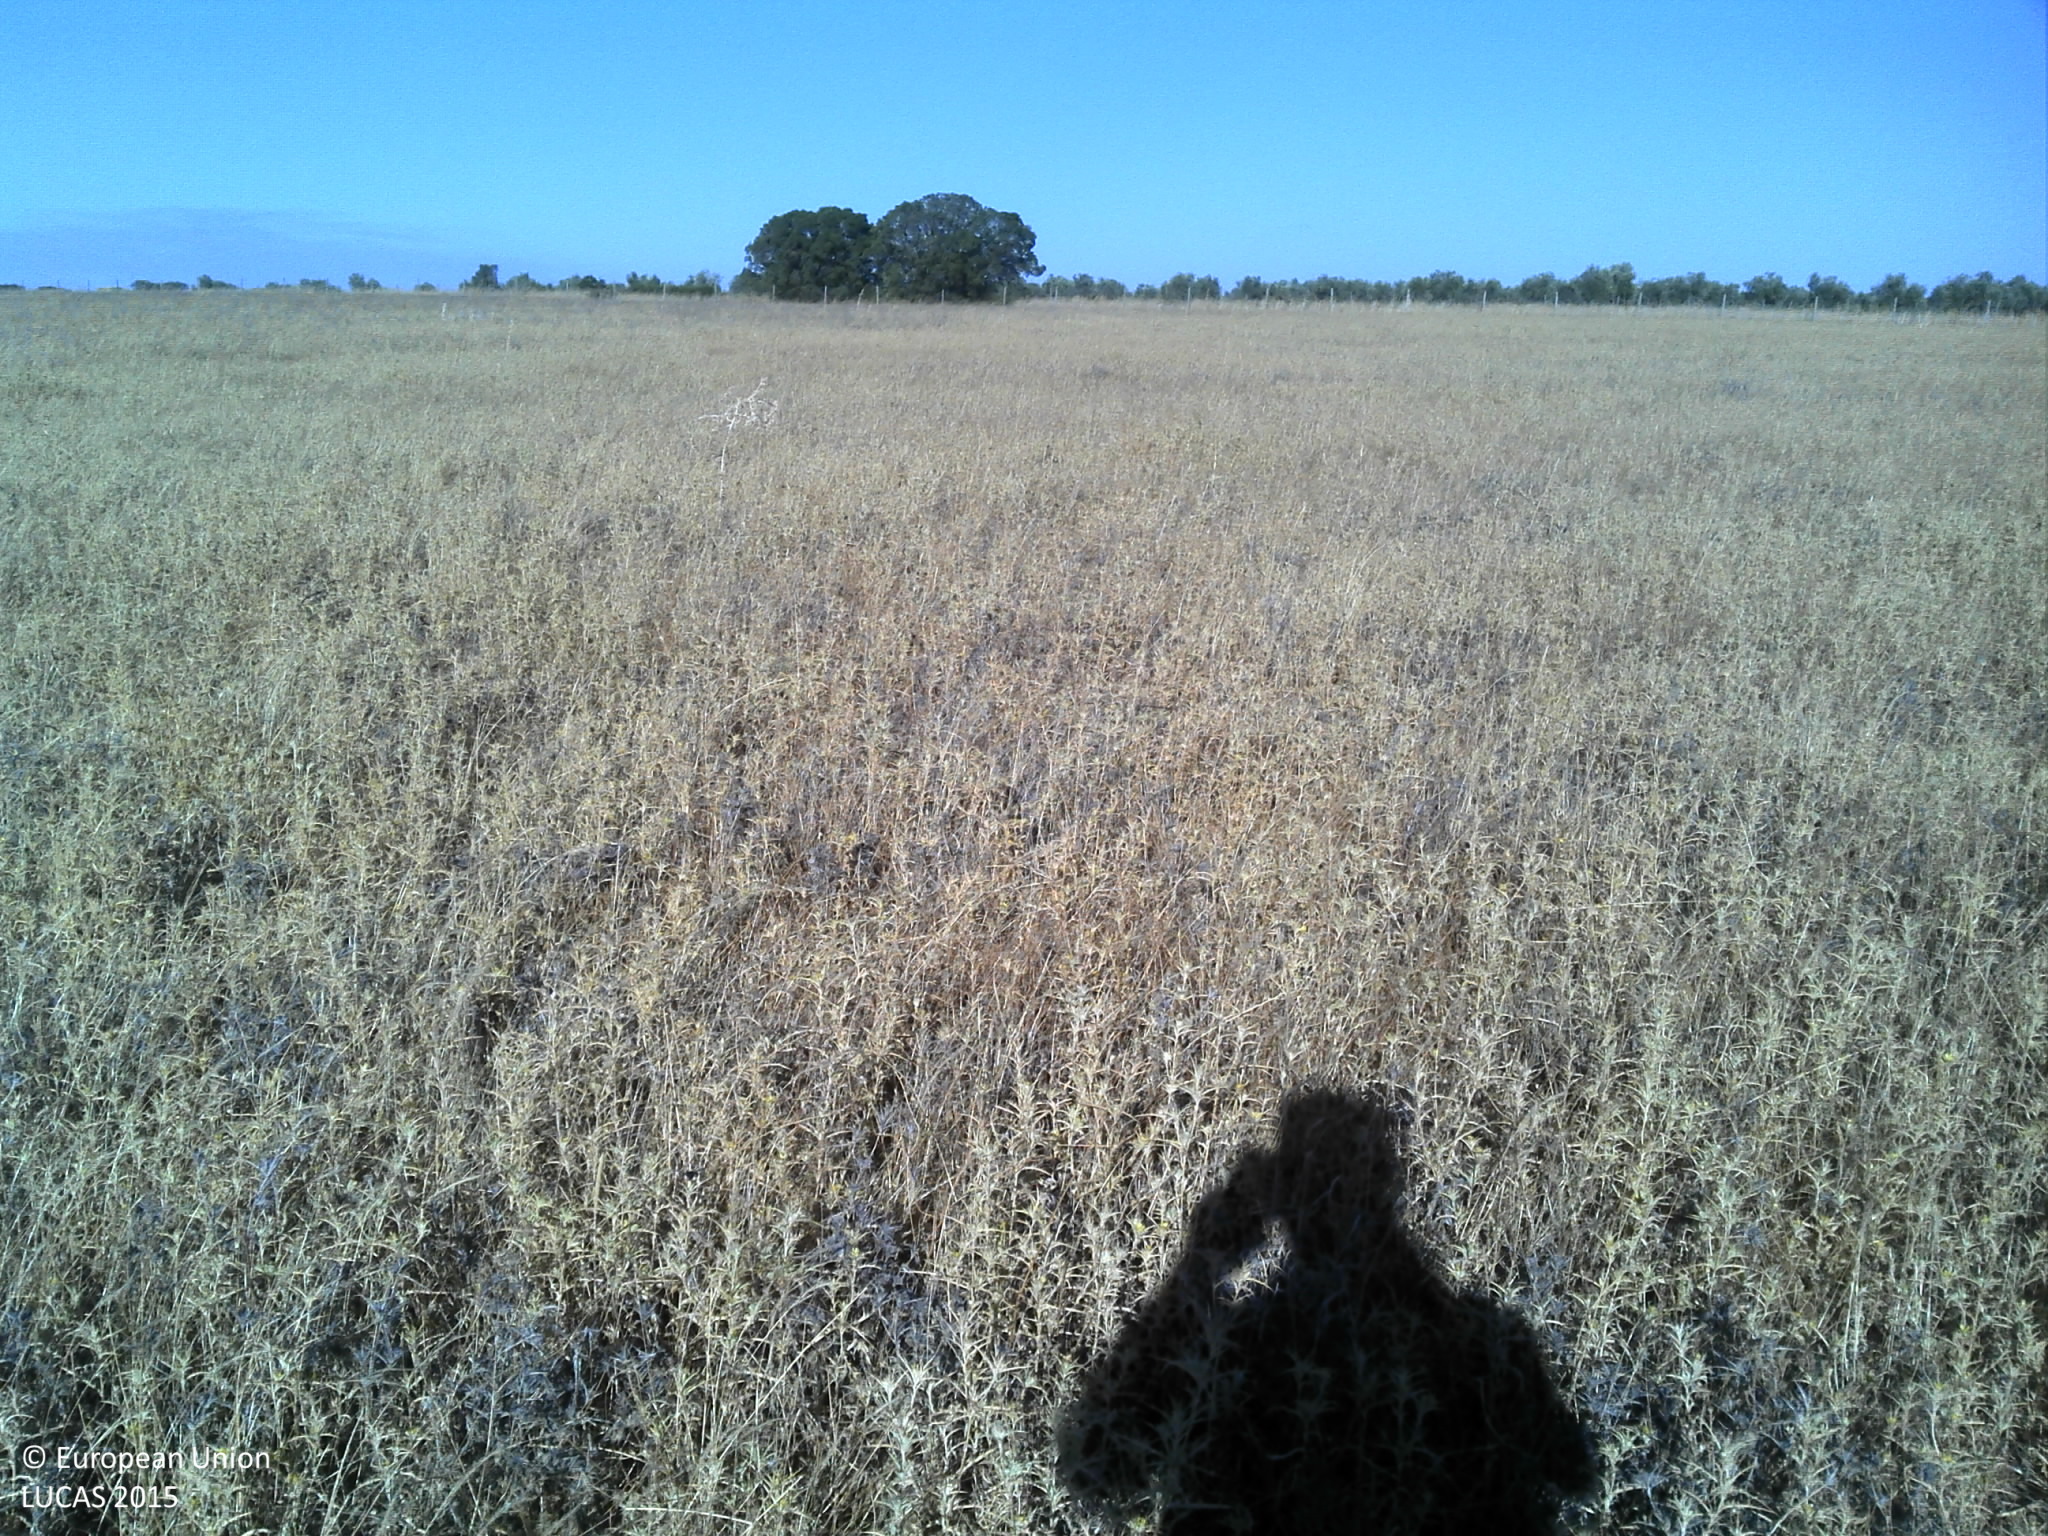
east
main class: Grassland
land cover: Grassland without tree/shrub cover
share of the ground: 50 - 75 %
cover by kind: herbaceous plants 70 %, unconsolidated bare surface 25 %
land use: Agriculture (excluding fallow land and kitchen gardens)
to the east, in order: Grassland without tree/shrub cover; Fences; Grassland without tree/shrub cover; Railways; Grassland with sparse tree/shrub cover; Fences; Grassland without tree/shrub cover; Tracks; Olive groves
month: July
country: PT
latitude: 37.9010
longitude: -8.0090
